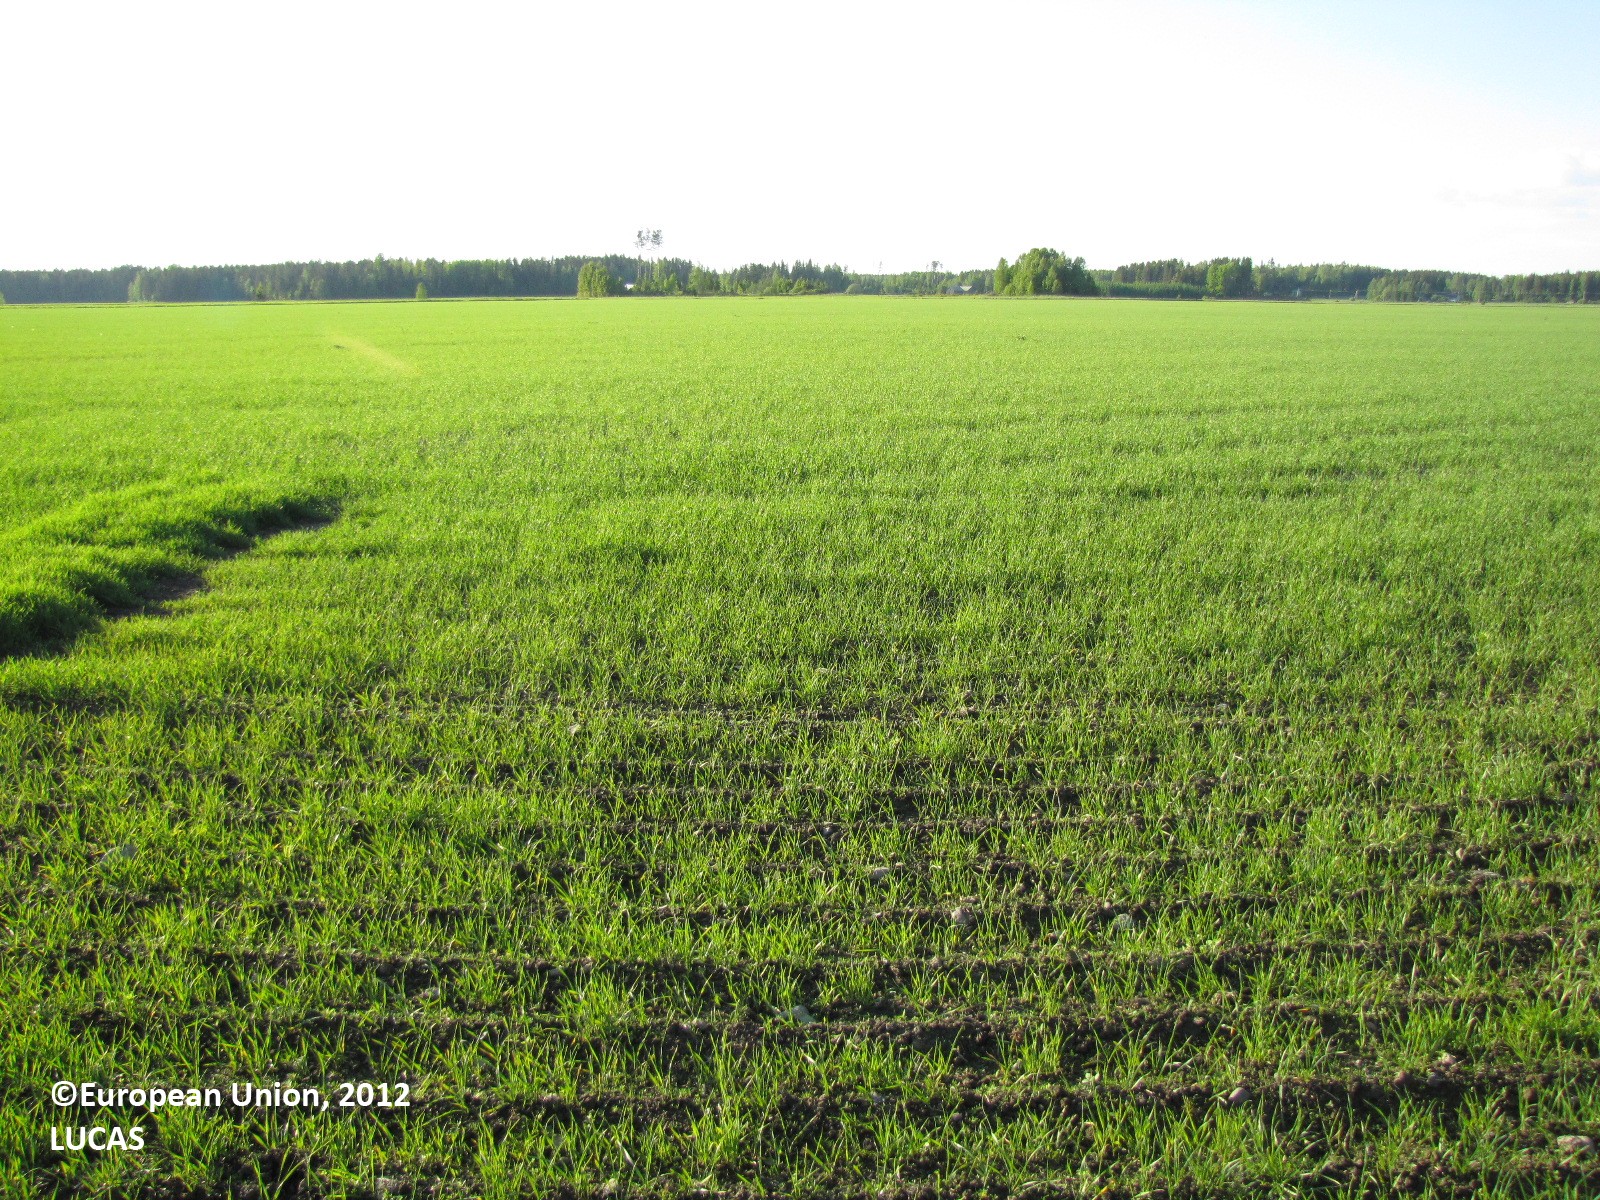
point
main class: Cropland
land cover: Common wheat
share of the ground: 25 - 50 %
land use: Agriculture (excluding fallow land and kitchen gardens)
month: June
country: FI
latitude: 61.2095
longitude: 22.9340
